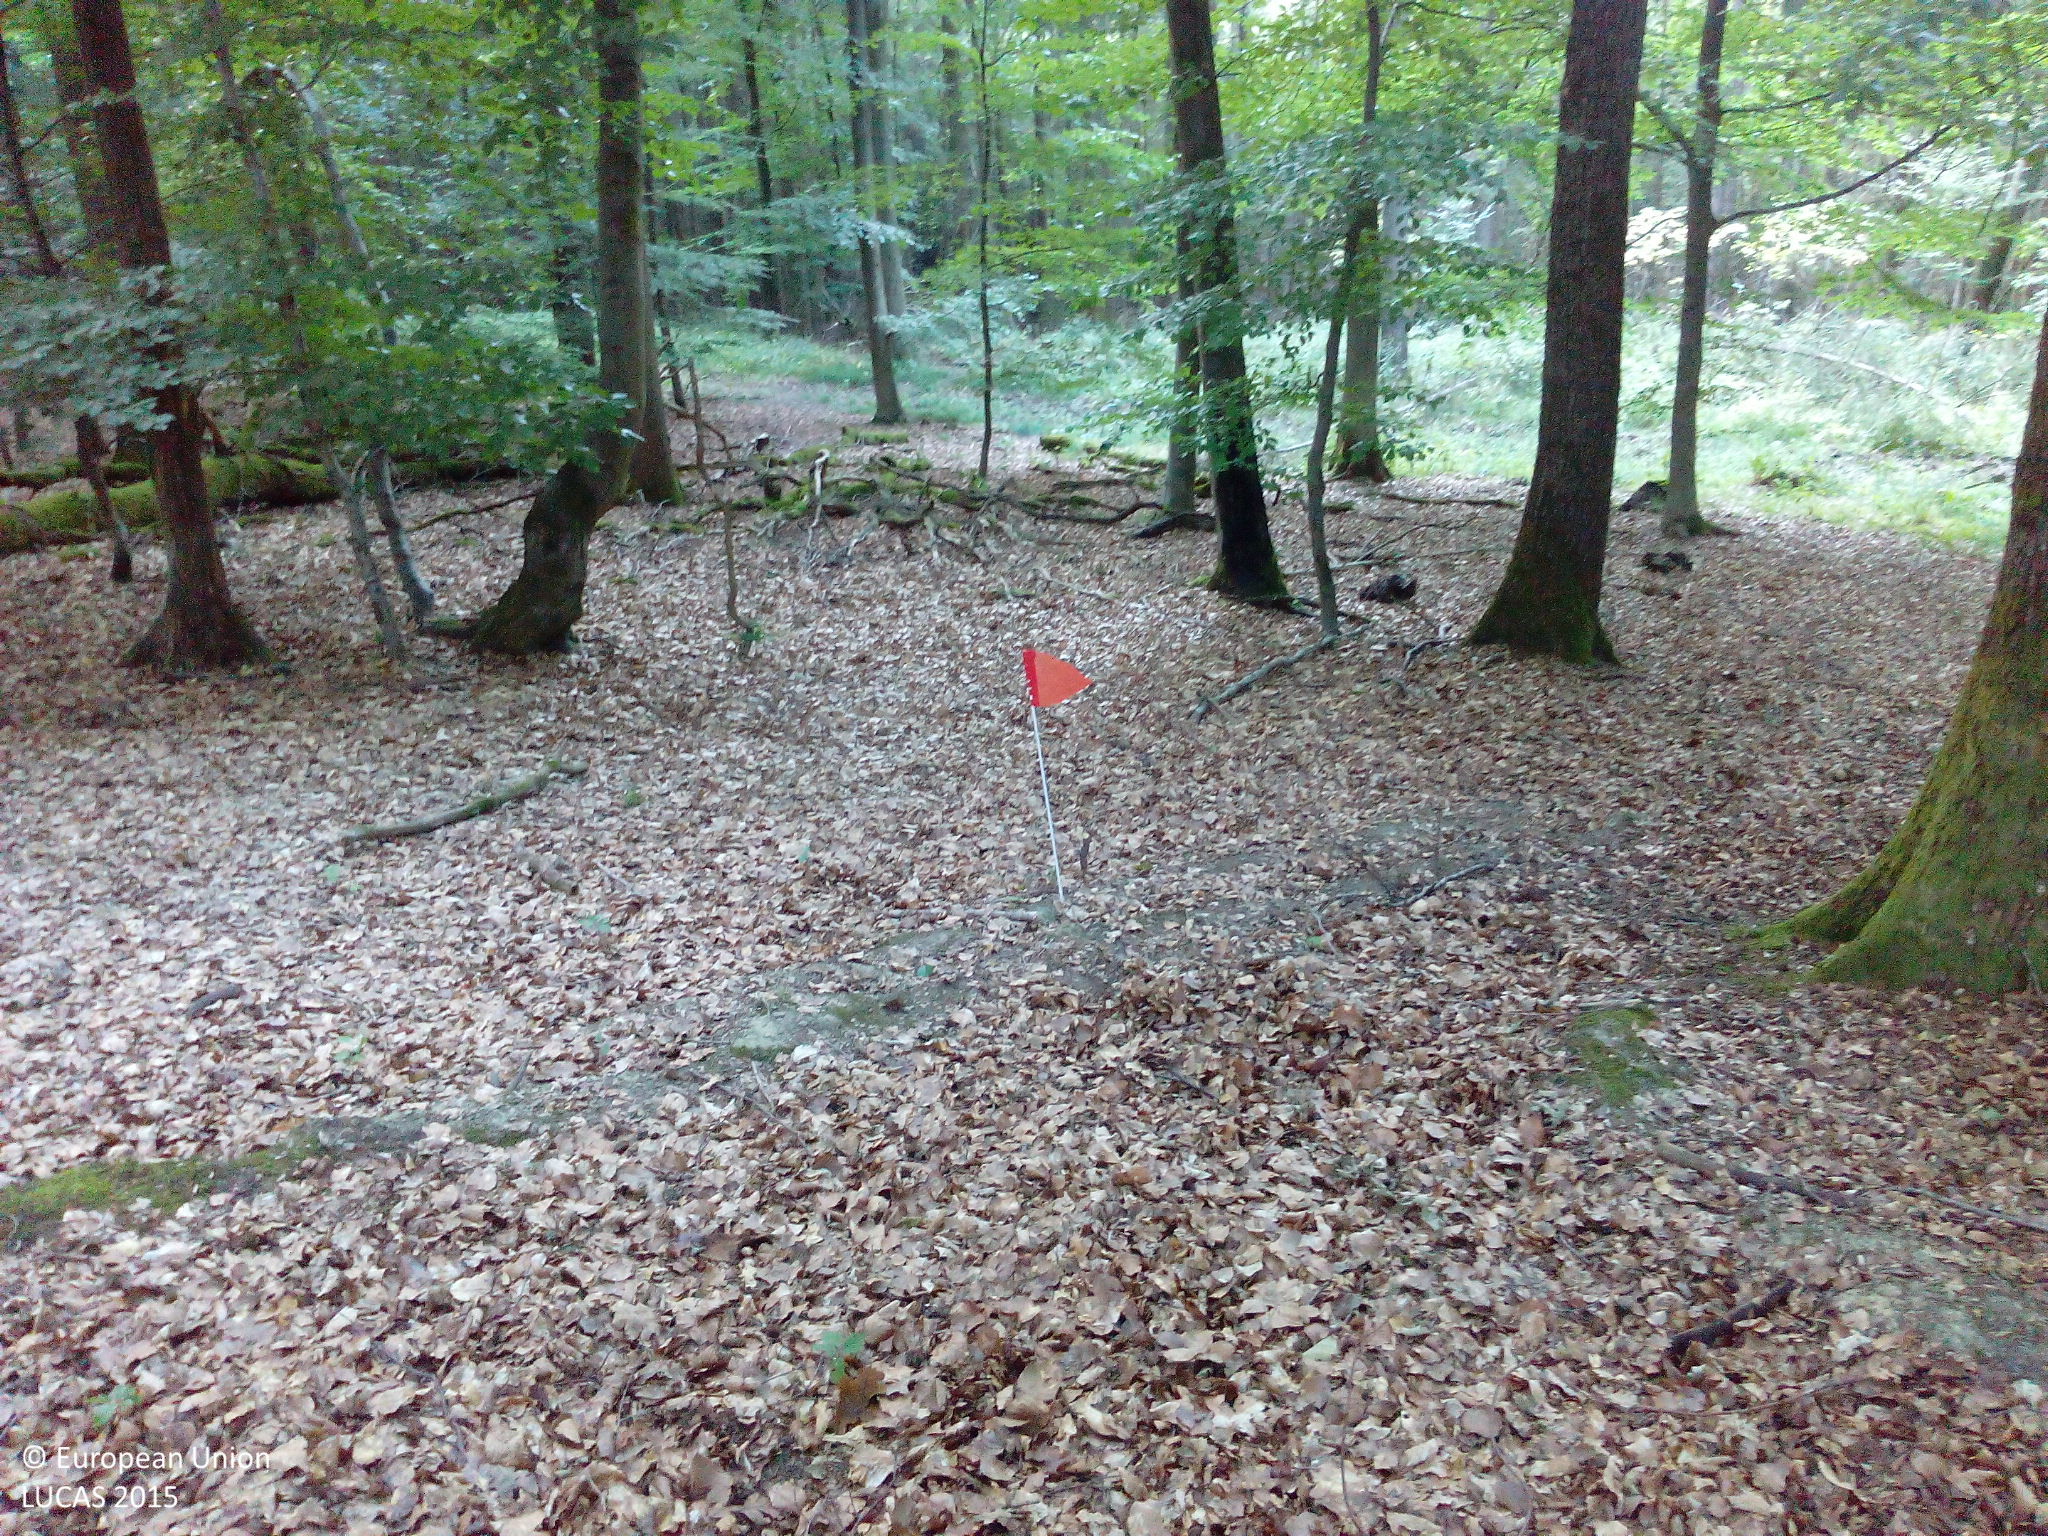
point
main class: Woodland
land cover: Broadleaved woodland
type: beech forest
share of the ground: > 75 %
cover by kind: broadleaved forest trees 90 %, unconsolidated bare surface 10 %
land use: Forestry
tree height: > 5 m
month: August
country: DE
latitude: 50.1034
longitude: 7.5256
